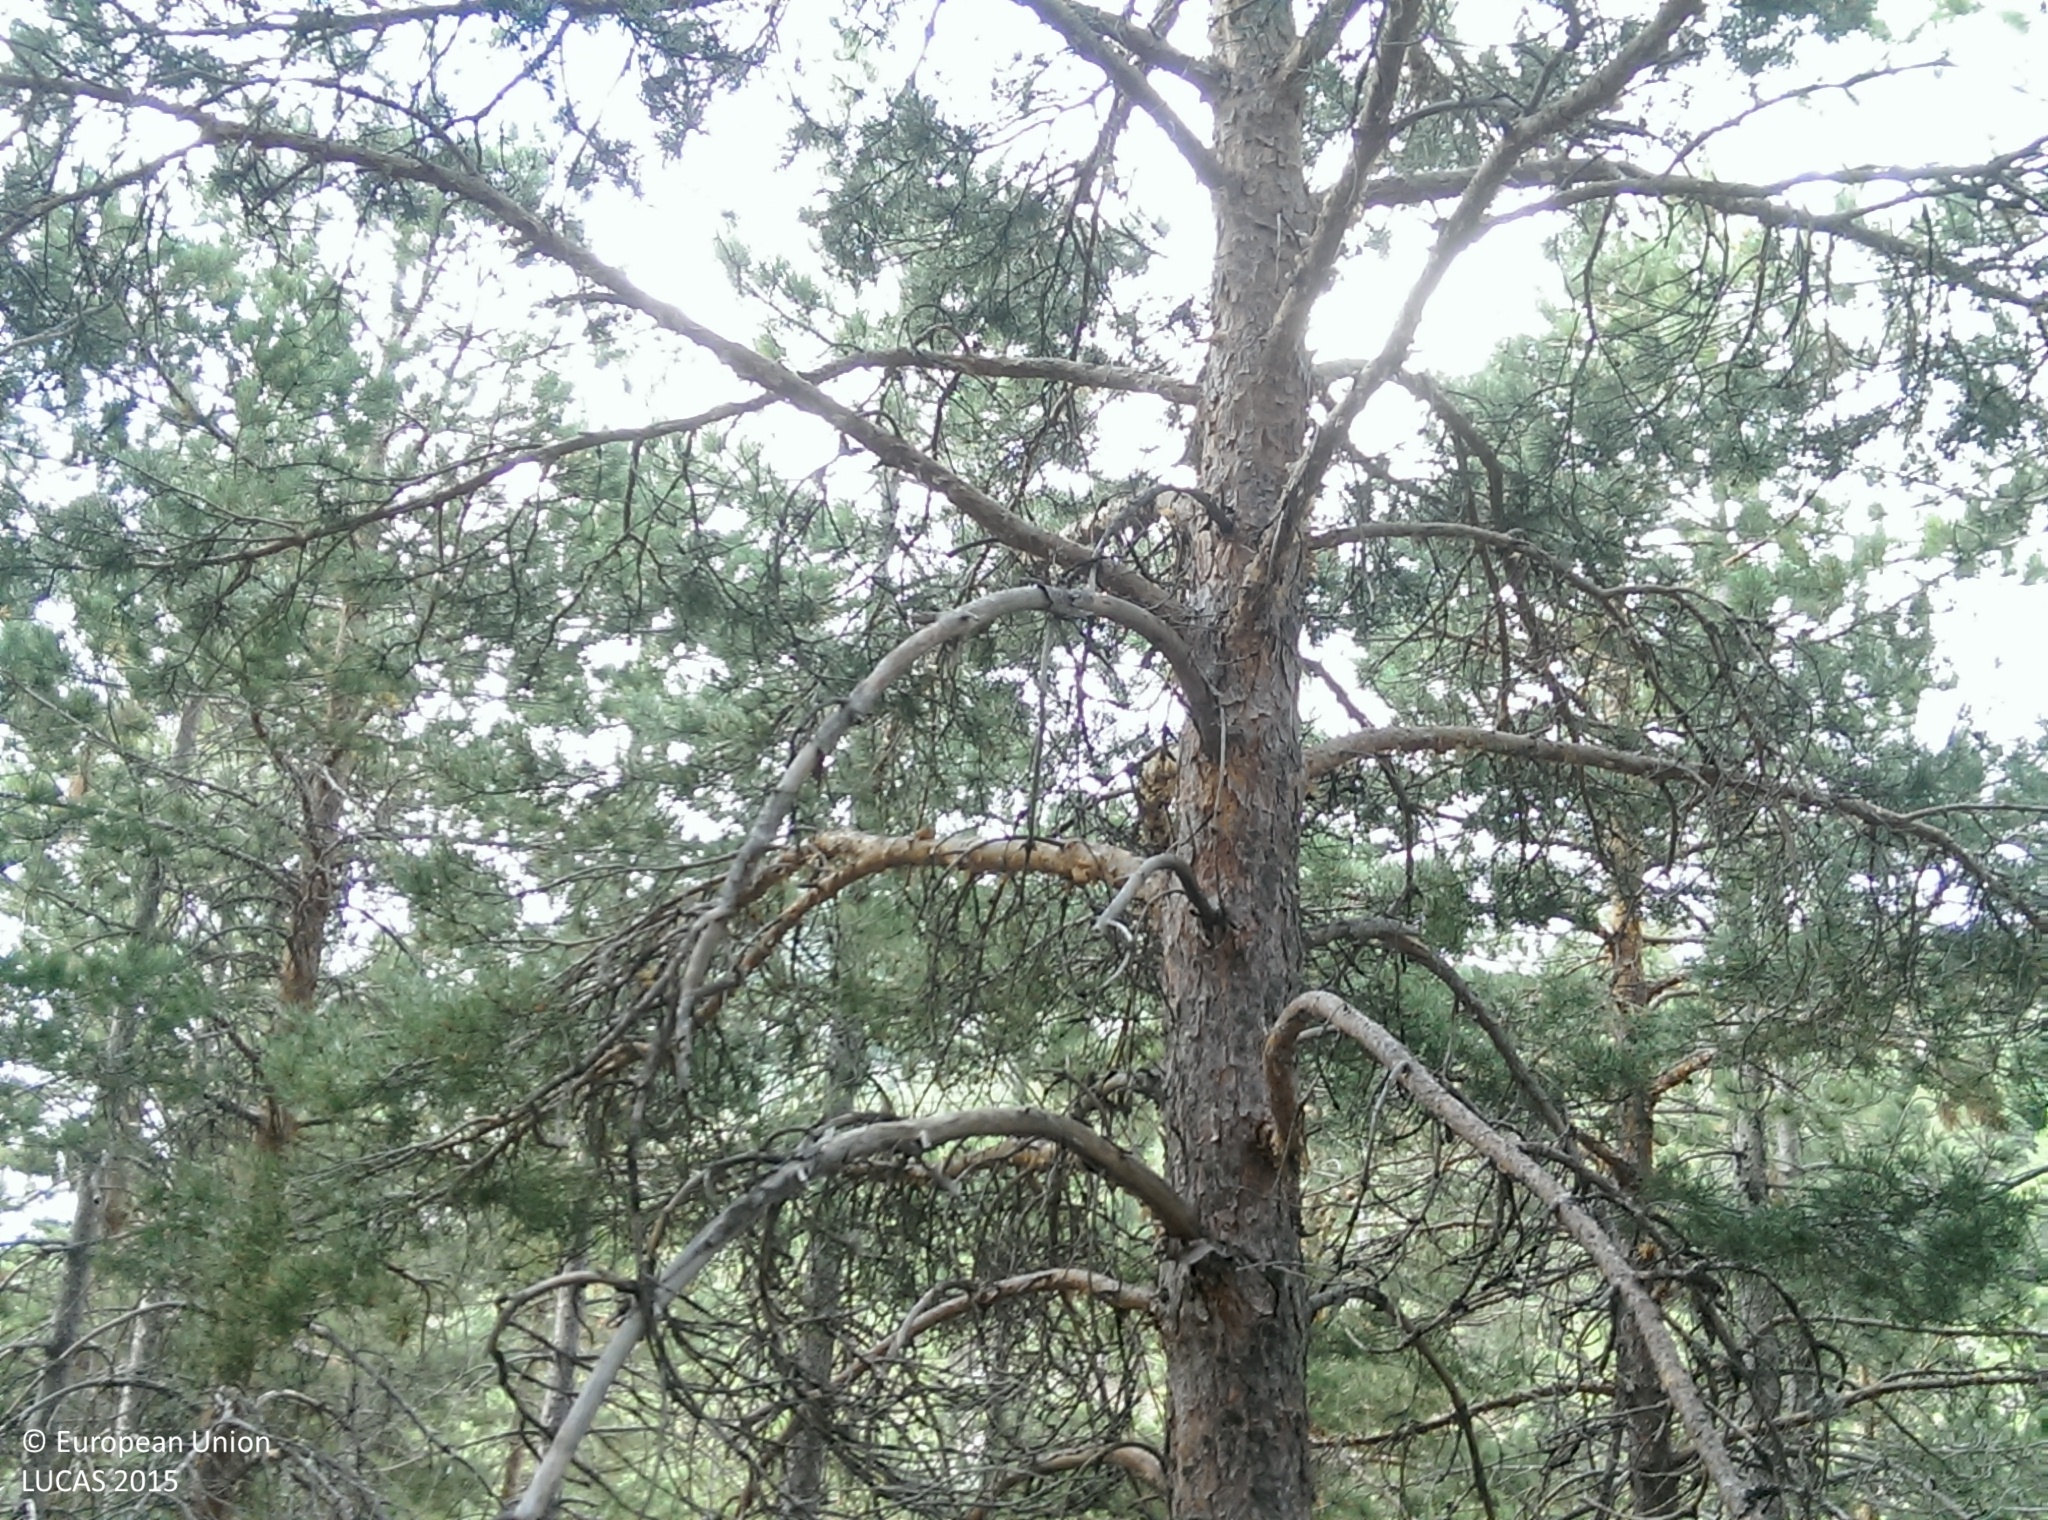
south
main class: Woodland
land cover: Pine dominated coniferous woodland
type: coniferous forest of the mediterranean region
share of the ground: > 75 %
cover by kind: coniferous forest trees 80 %, shrubs 10 %, consolidated bare surface 5 %, unconsolidated bare surface 5 %
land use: Forestry
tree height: > 5 m
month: July
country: ES
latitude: 37.3613
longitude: -2.8913
